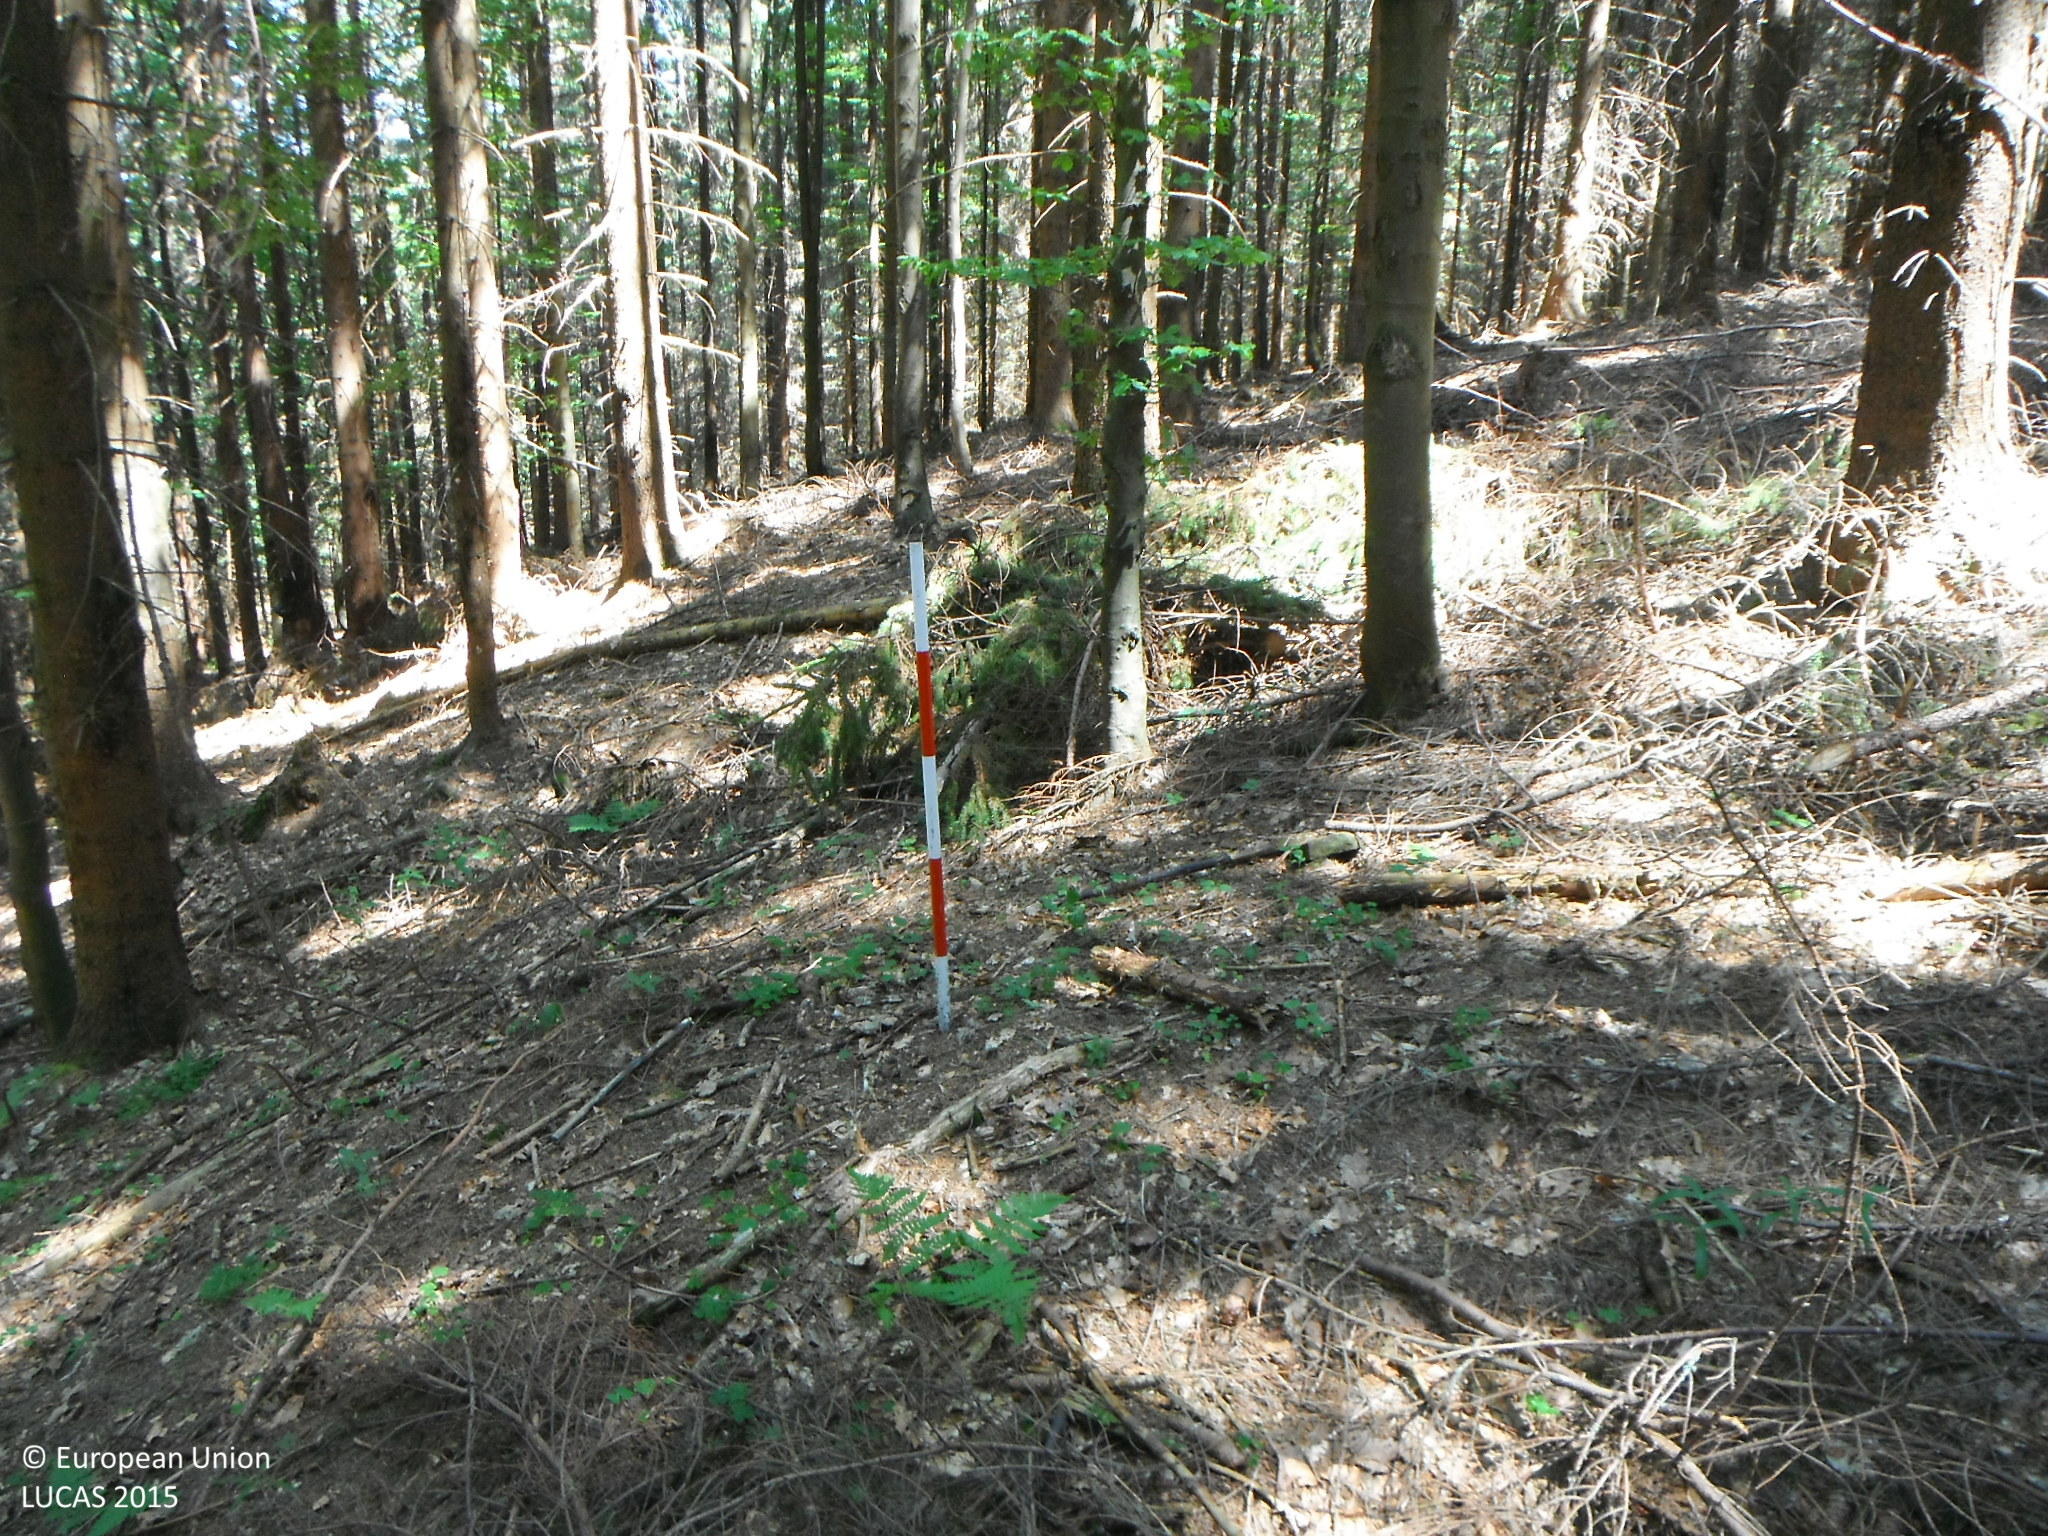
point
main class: Woodland
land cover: Spruce dominated mixed woodland
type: hemiboreal forest and nemoral coniferous forest and mixed broadleaved-coniferous forest
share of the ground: > 75 %
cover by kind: coniferous forest trees 70 %, broadleaved forest trees 30 %
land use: Forestry
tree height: > 5 m
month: July
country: SK
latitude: 49.3718
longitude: 19.2654
